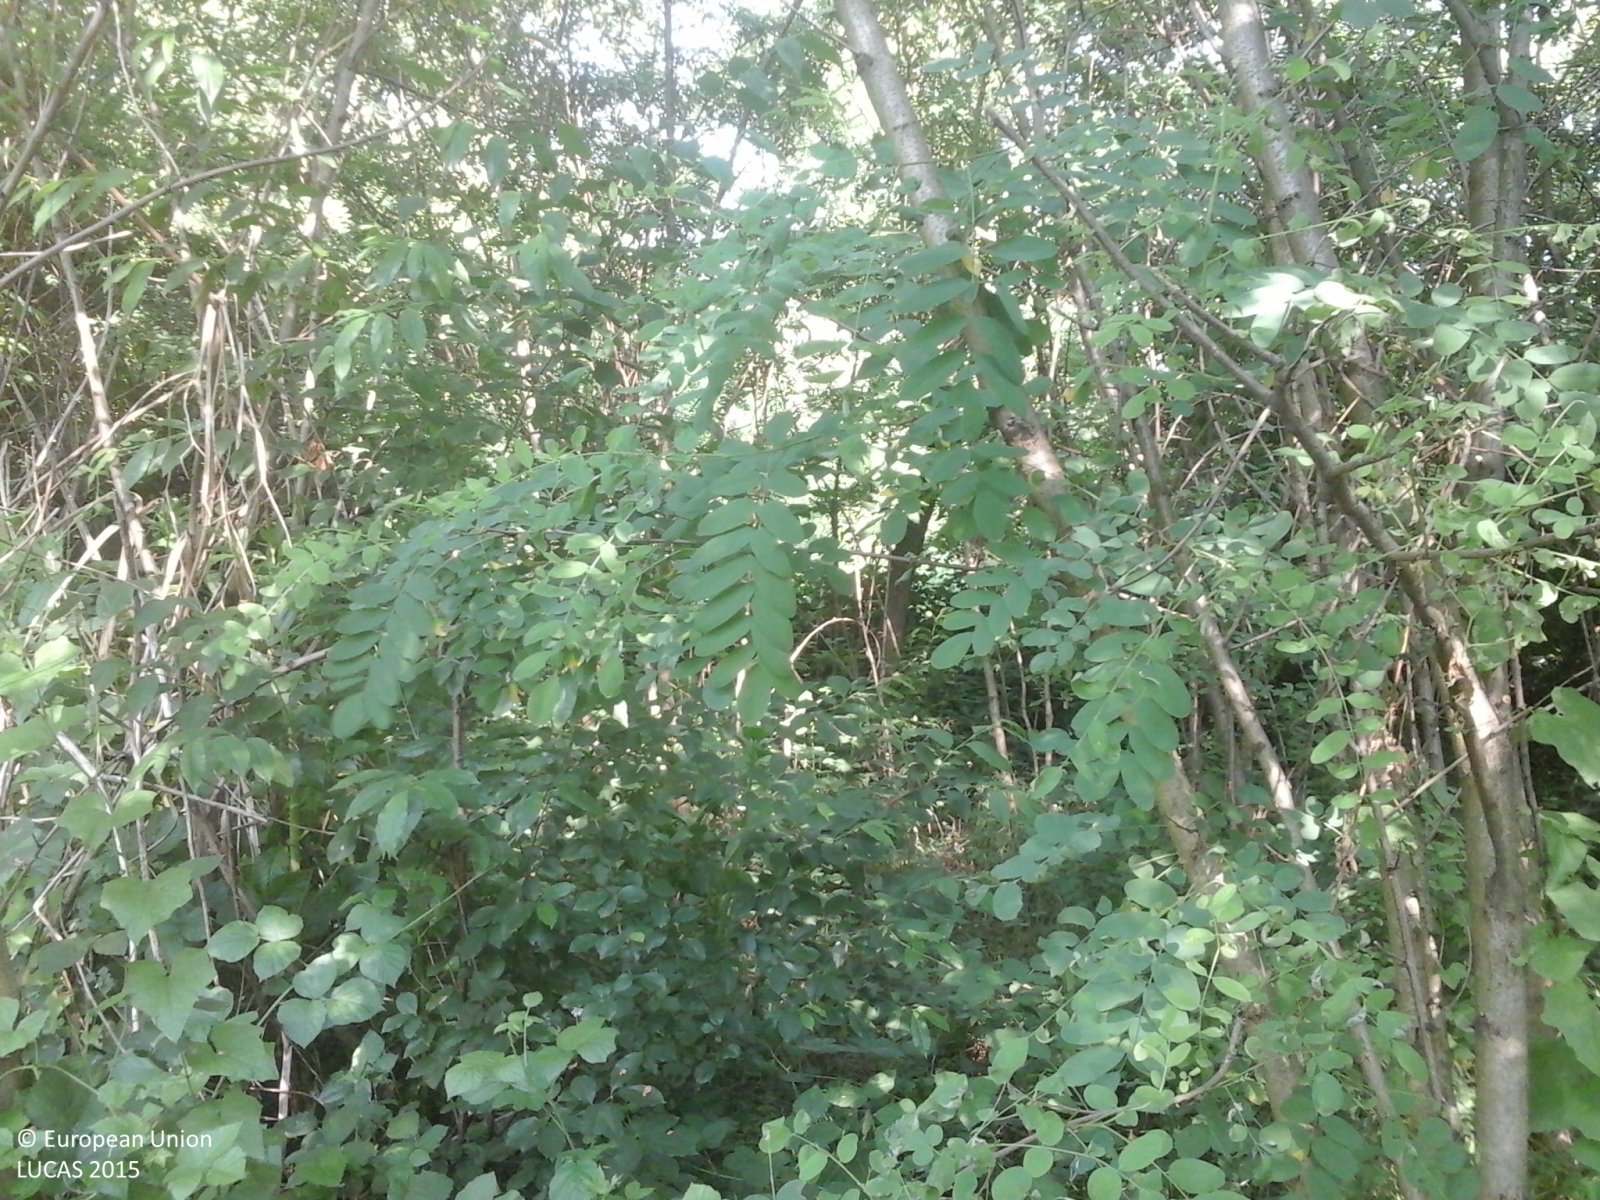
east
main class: Woodland
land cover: Broadleaved woodland
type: exotic forest
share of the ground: > 75 %
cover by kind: broadleaved forest trees 80 %, herbaceous plants 20 %
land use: Forestry
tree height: > 5 m
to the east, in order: Broadleaved woodland; Ditches and canals; Groves; Inland fresh running water; Groves; Spontaneously vegetated surfaces; Broadleaved woodland; Tracks; Triticale
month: June
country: IT
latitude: 45.5338
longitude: 8.8111
